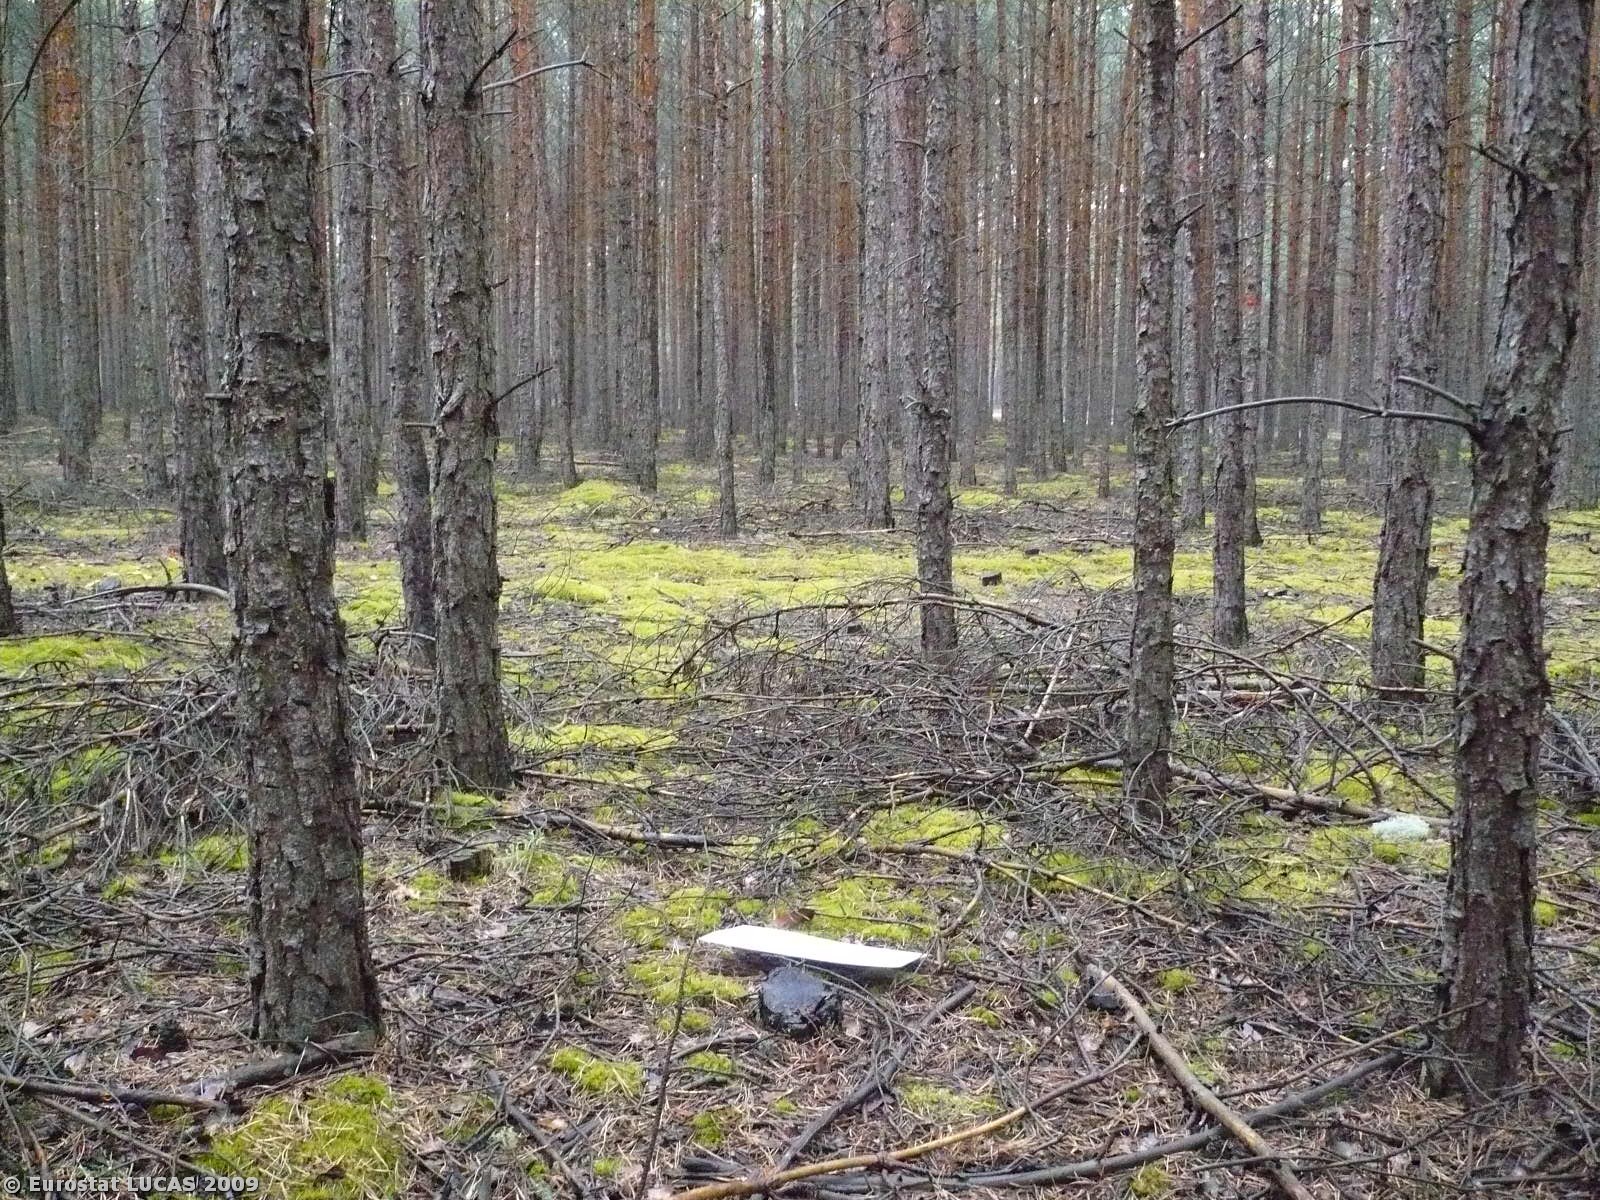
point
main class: Woodland
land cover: Coniferous woodland
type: hemiboreal forest and nemoral coniferous forest and mixed broadleaved-coniferous forest
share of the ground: > 75 %
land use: Forestry
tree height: > 5 m
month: May
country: PL
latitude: 51.7398
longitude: 15.2314
